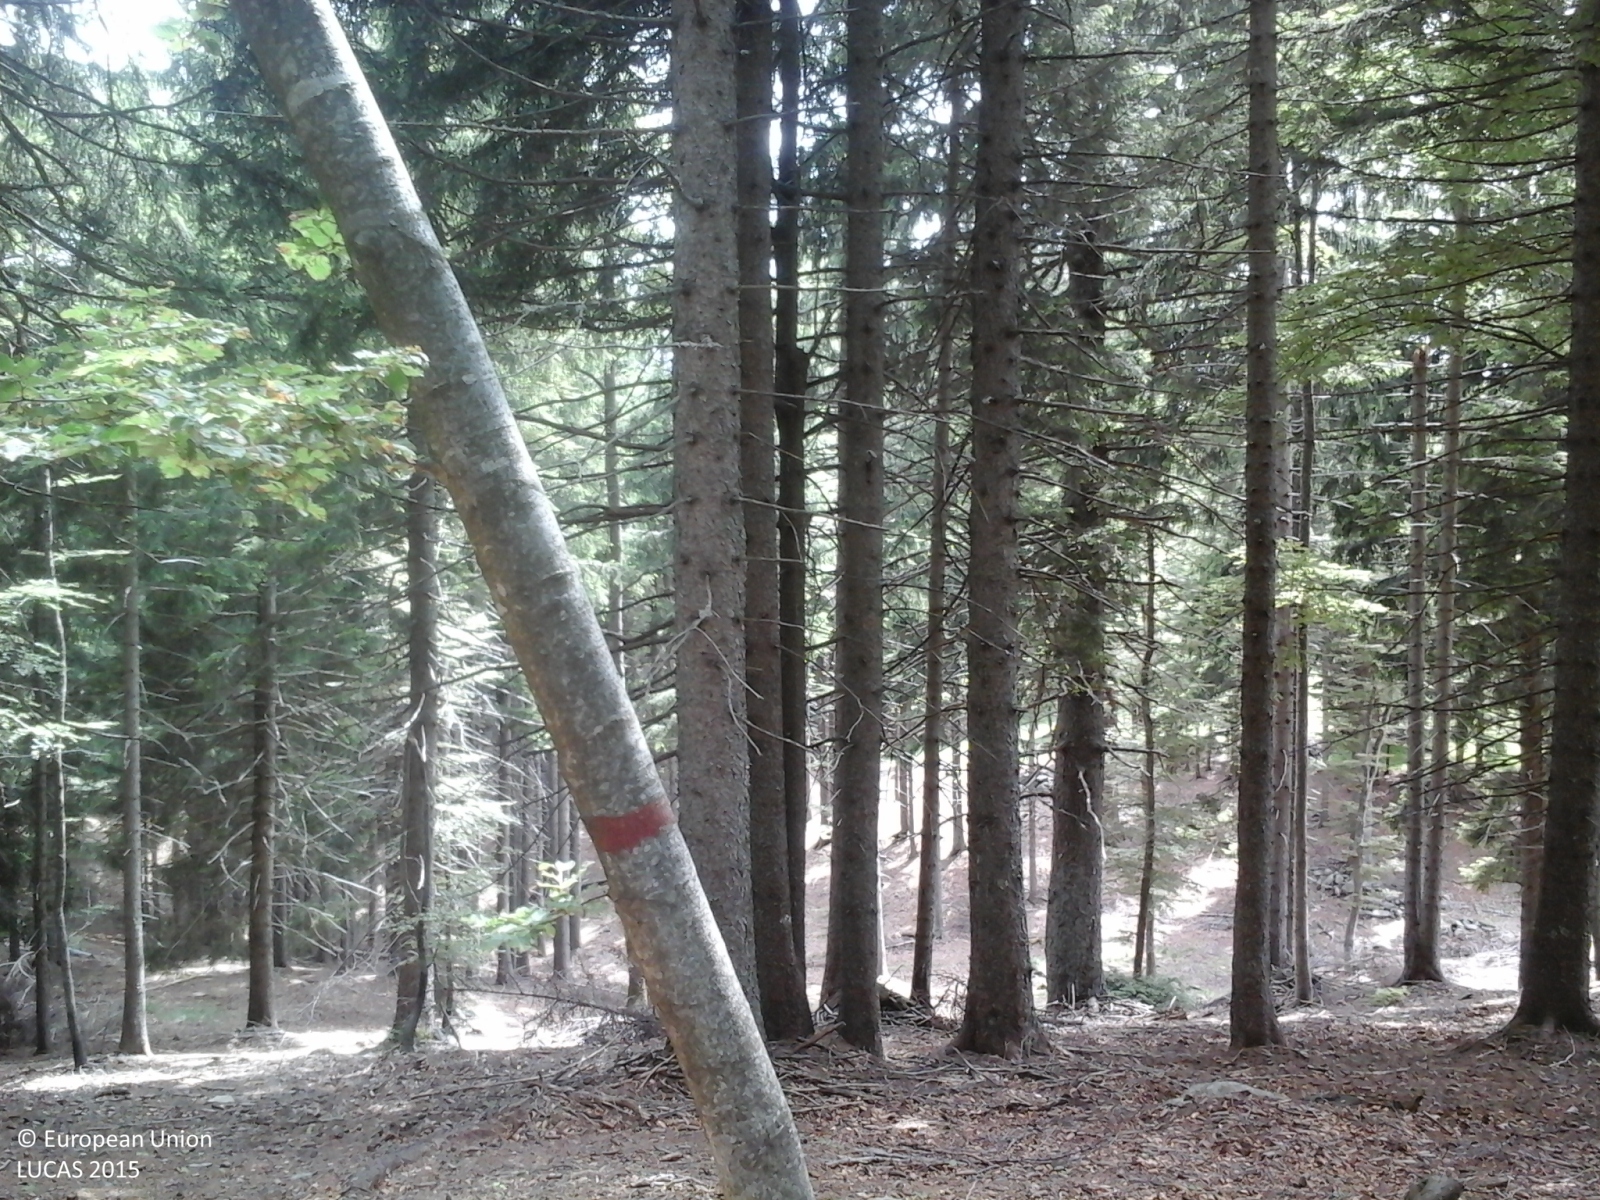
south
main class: Woodland
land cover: Other coniferous woodland
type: alpine coniferous forest
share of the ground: > 75 %
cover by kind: coniferous forest trees 95 %, broadleaved forest trees 5 %
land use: Forestry
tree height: > 5 m
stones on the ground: 10 - 25 %
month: June
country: IT
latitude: 46.1404
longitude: 8.3582
